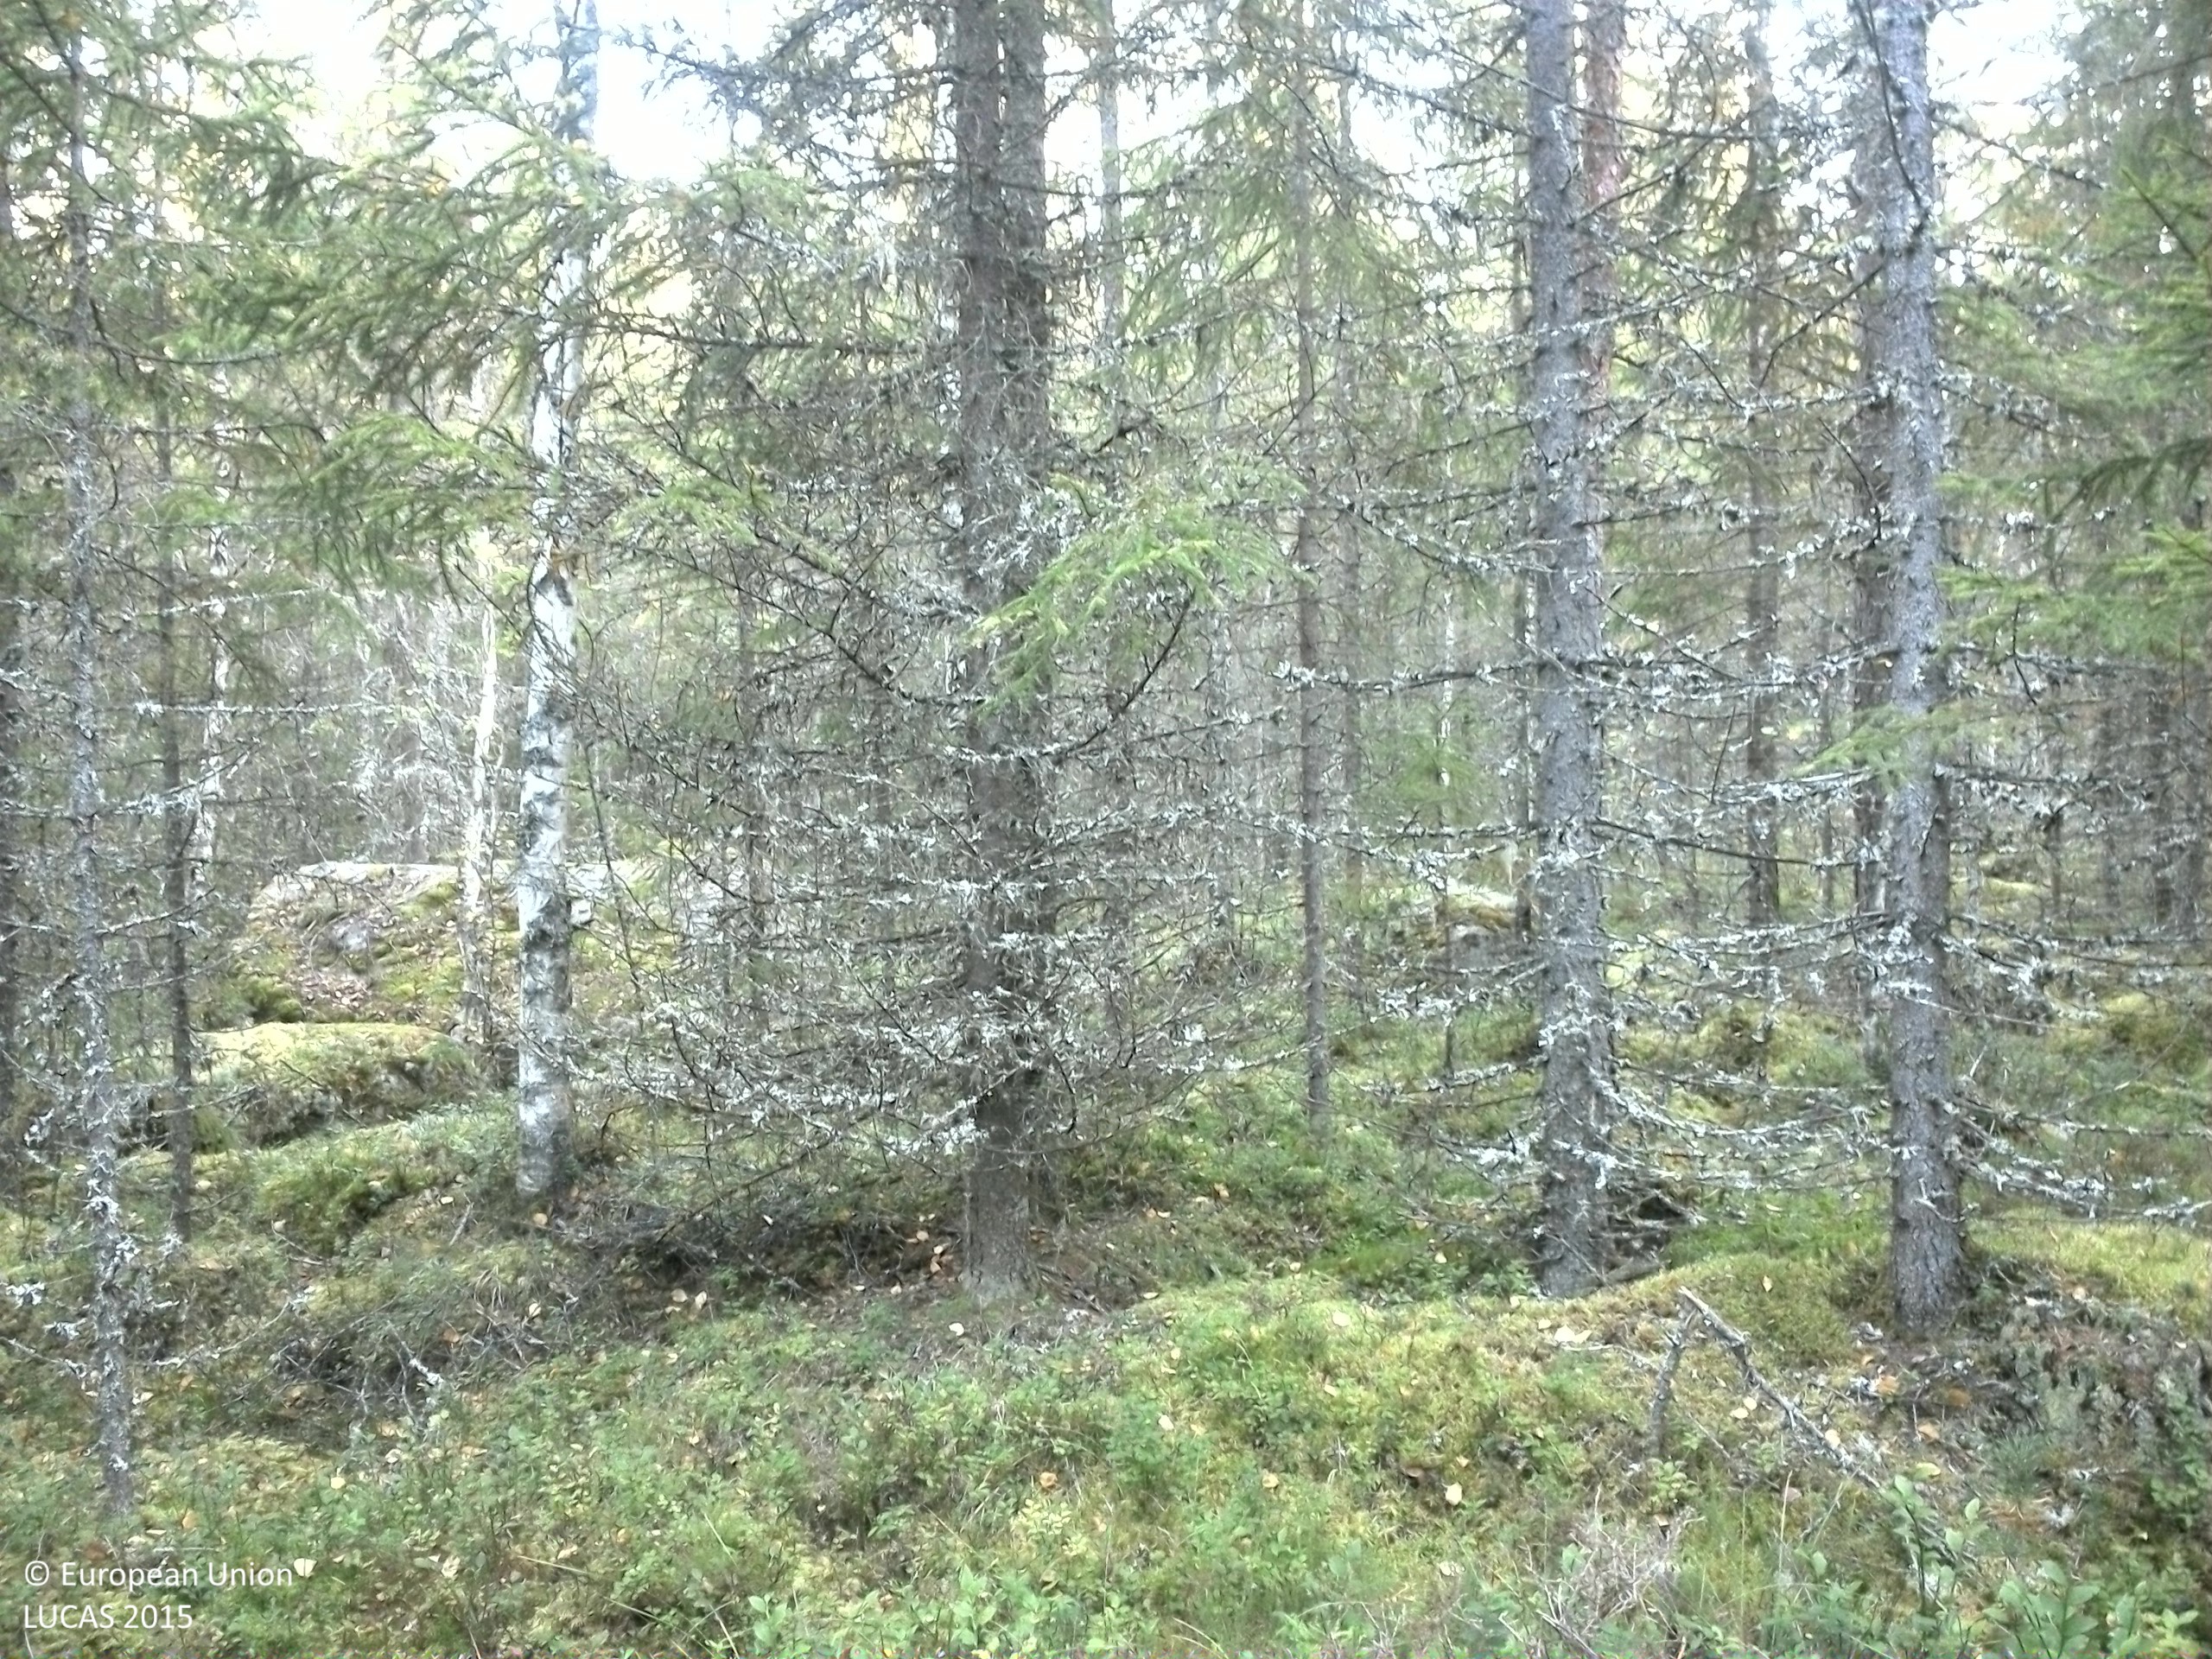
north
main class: Woodland
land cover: Spruce dominated coniferous woodland
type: boreal forest
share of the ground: 50 - 75 %
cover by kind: coniferous forest trees 70 %, shrubs 15 %, lichens and mosses 10 %, broadleaved forest trees 5 %
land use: Forestry
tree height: > 5 m
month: September
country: SE
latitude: 59.9036
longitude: 13.4773
